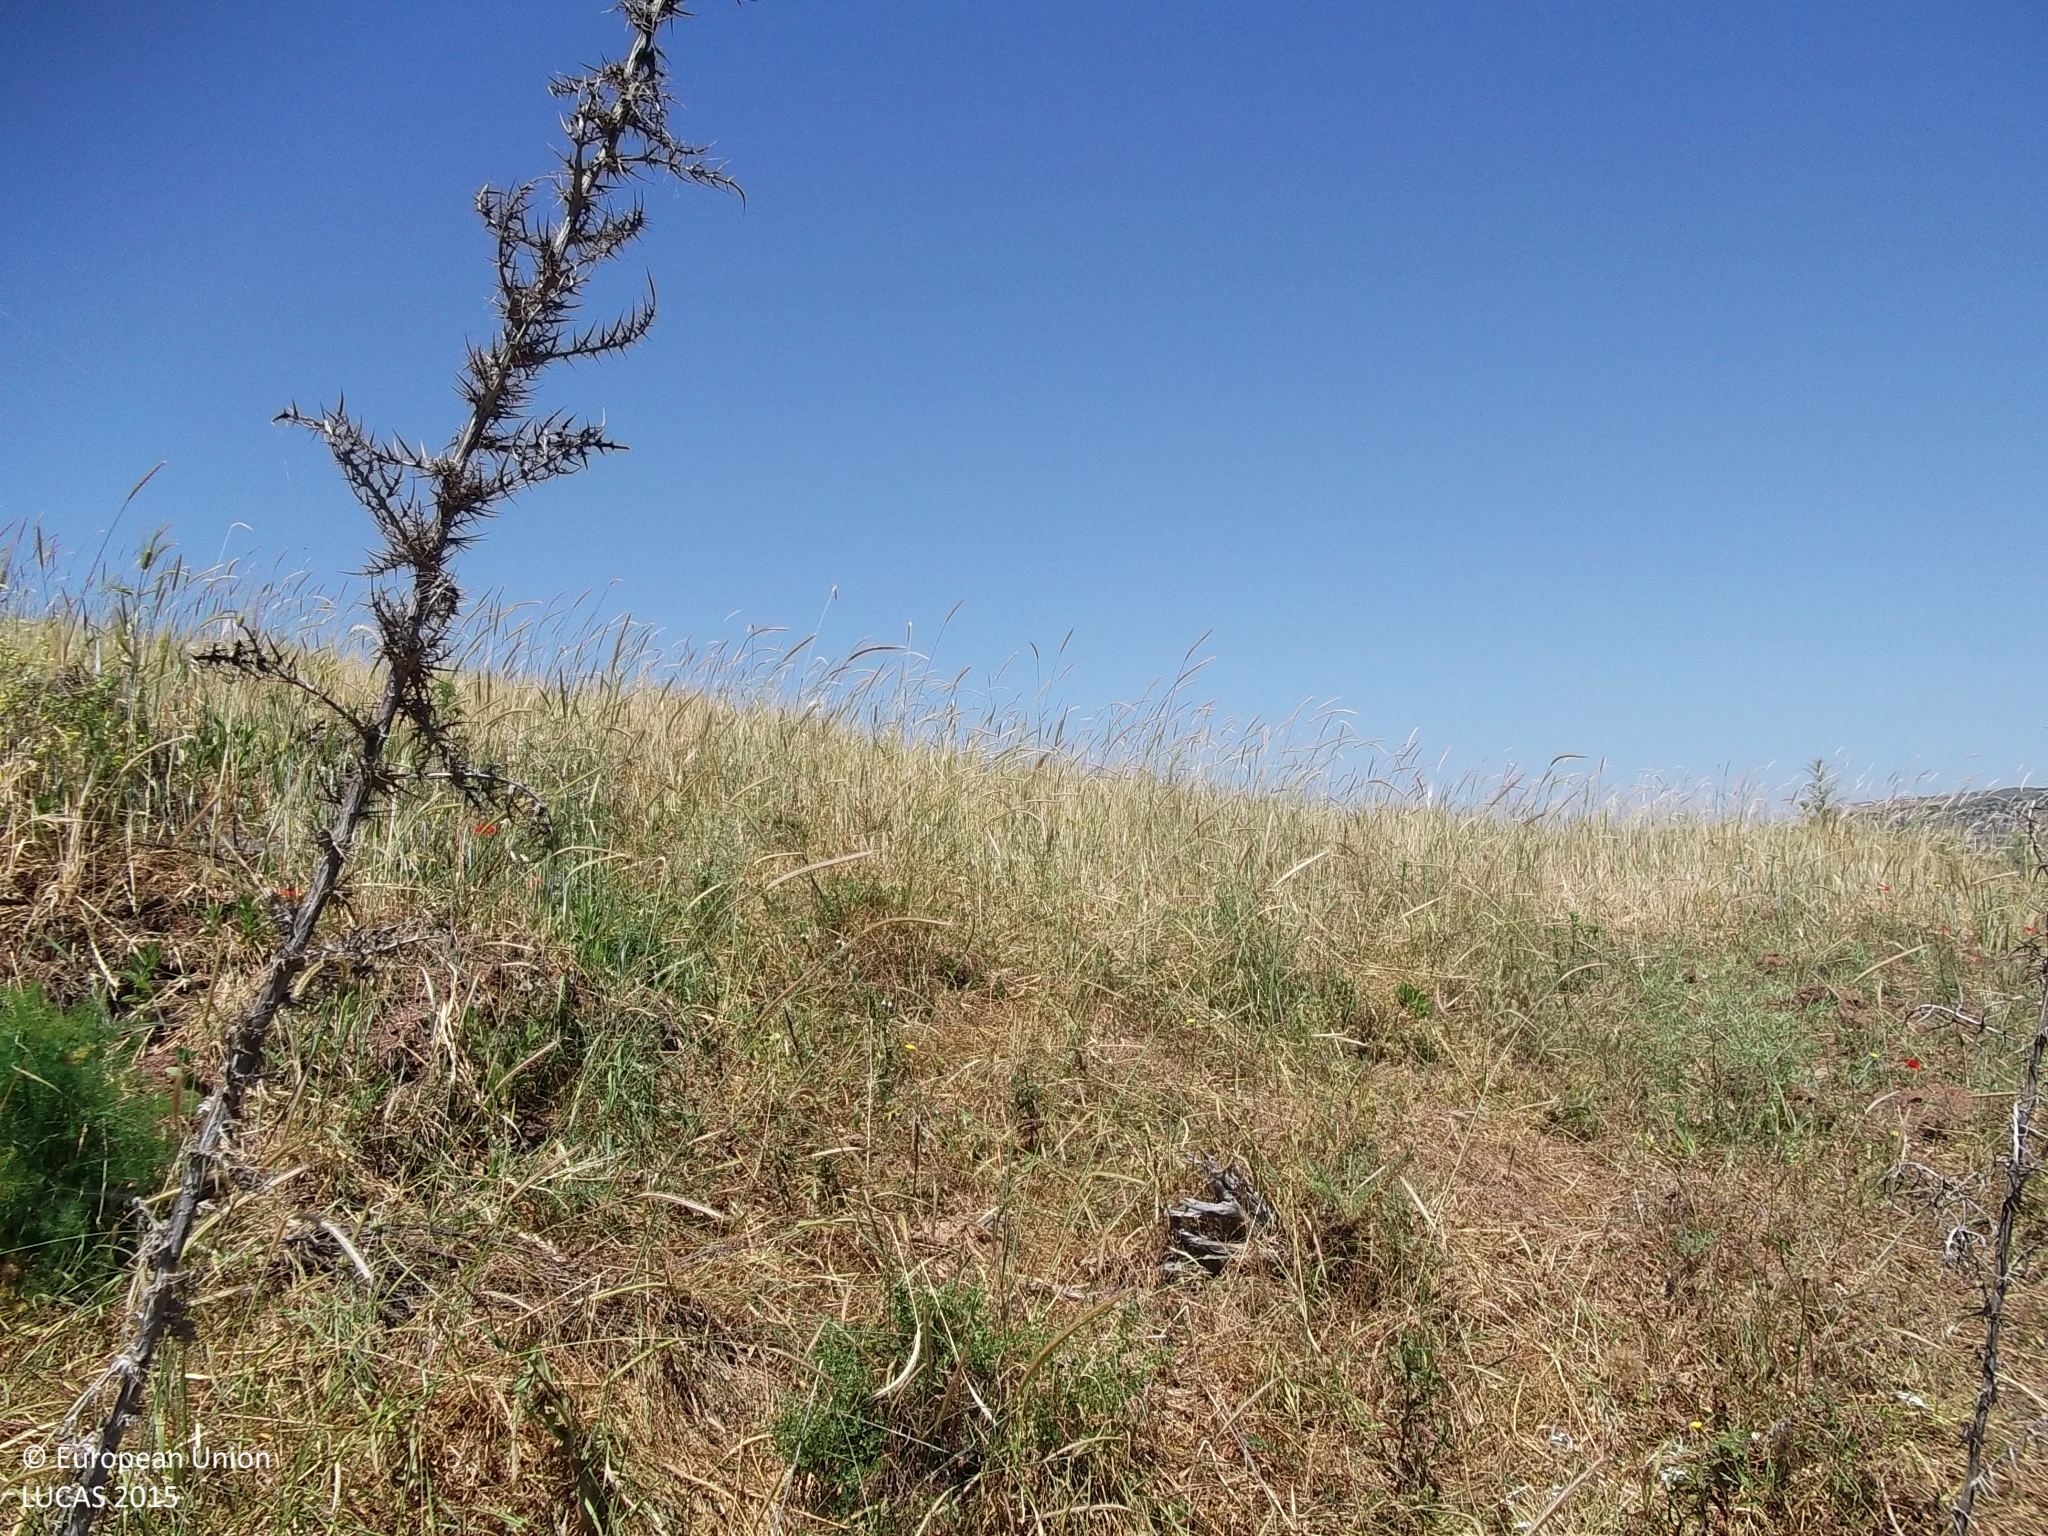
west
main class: Grassland
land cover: Grassland without tree/shrub cover
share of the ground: > 75 %
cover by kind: herbaceous plants 95 %, shrubs 5 %
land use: Semi-natural and natural areas not in use
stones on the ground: 25 - 50 %
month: May
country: CY
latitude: 34.7793
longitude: 32.5395
